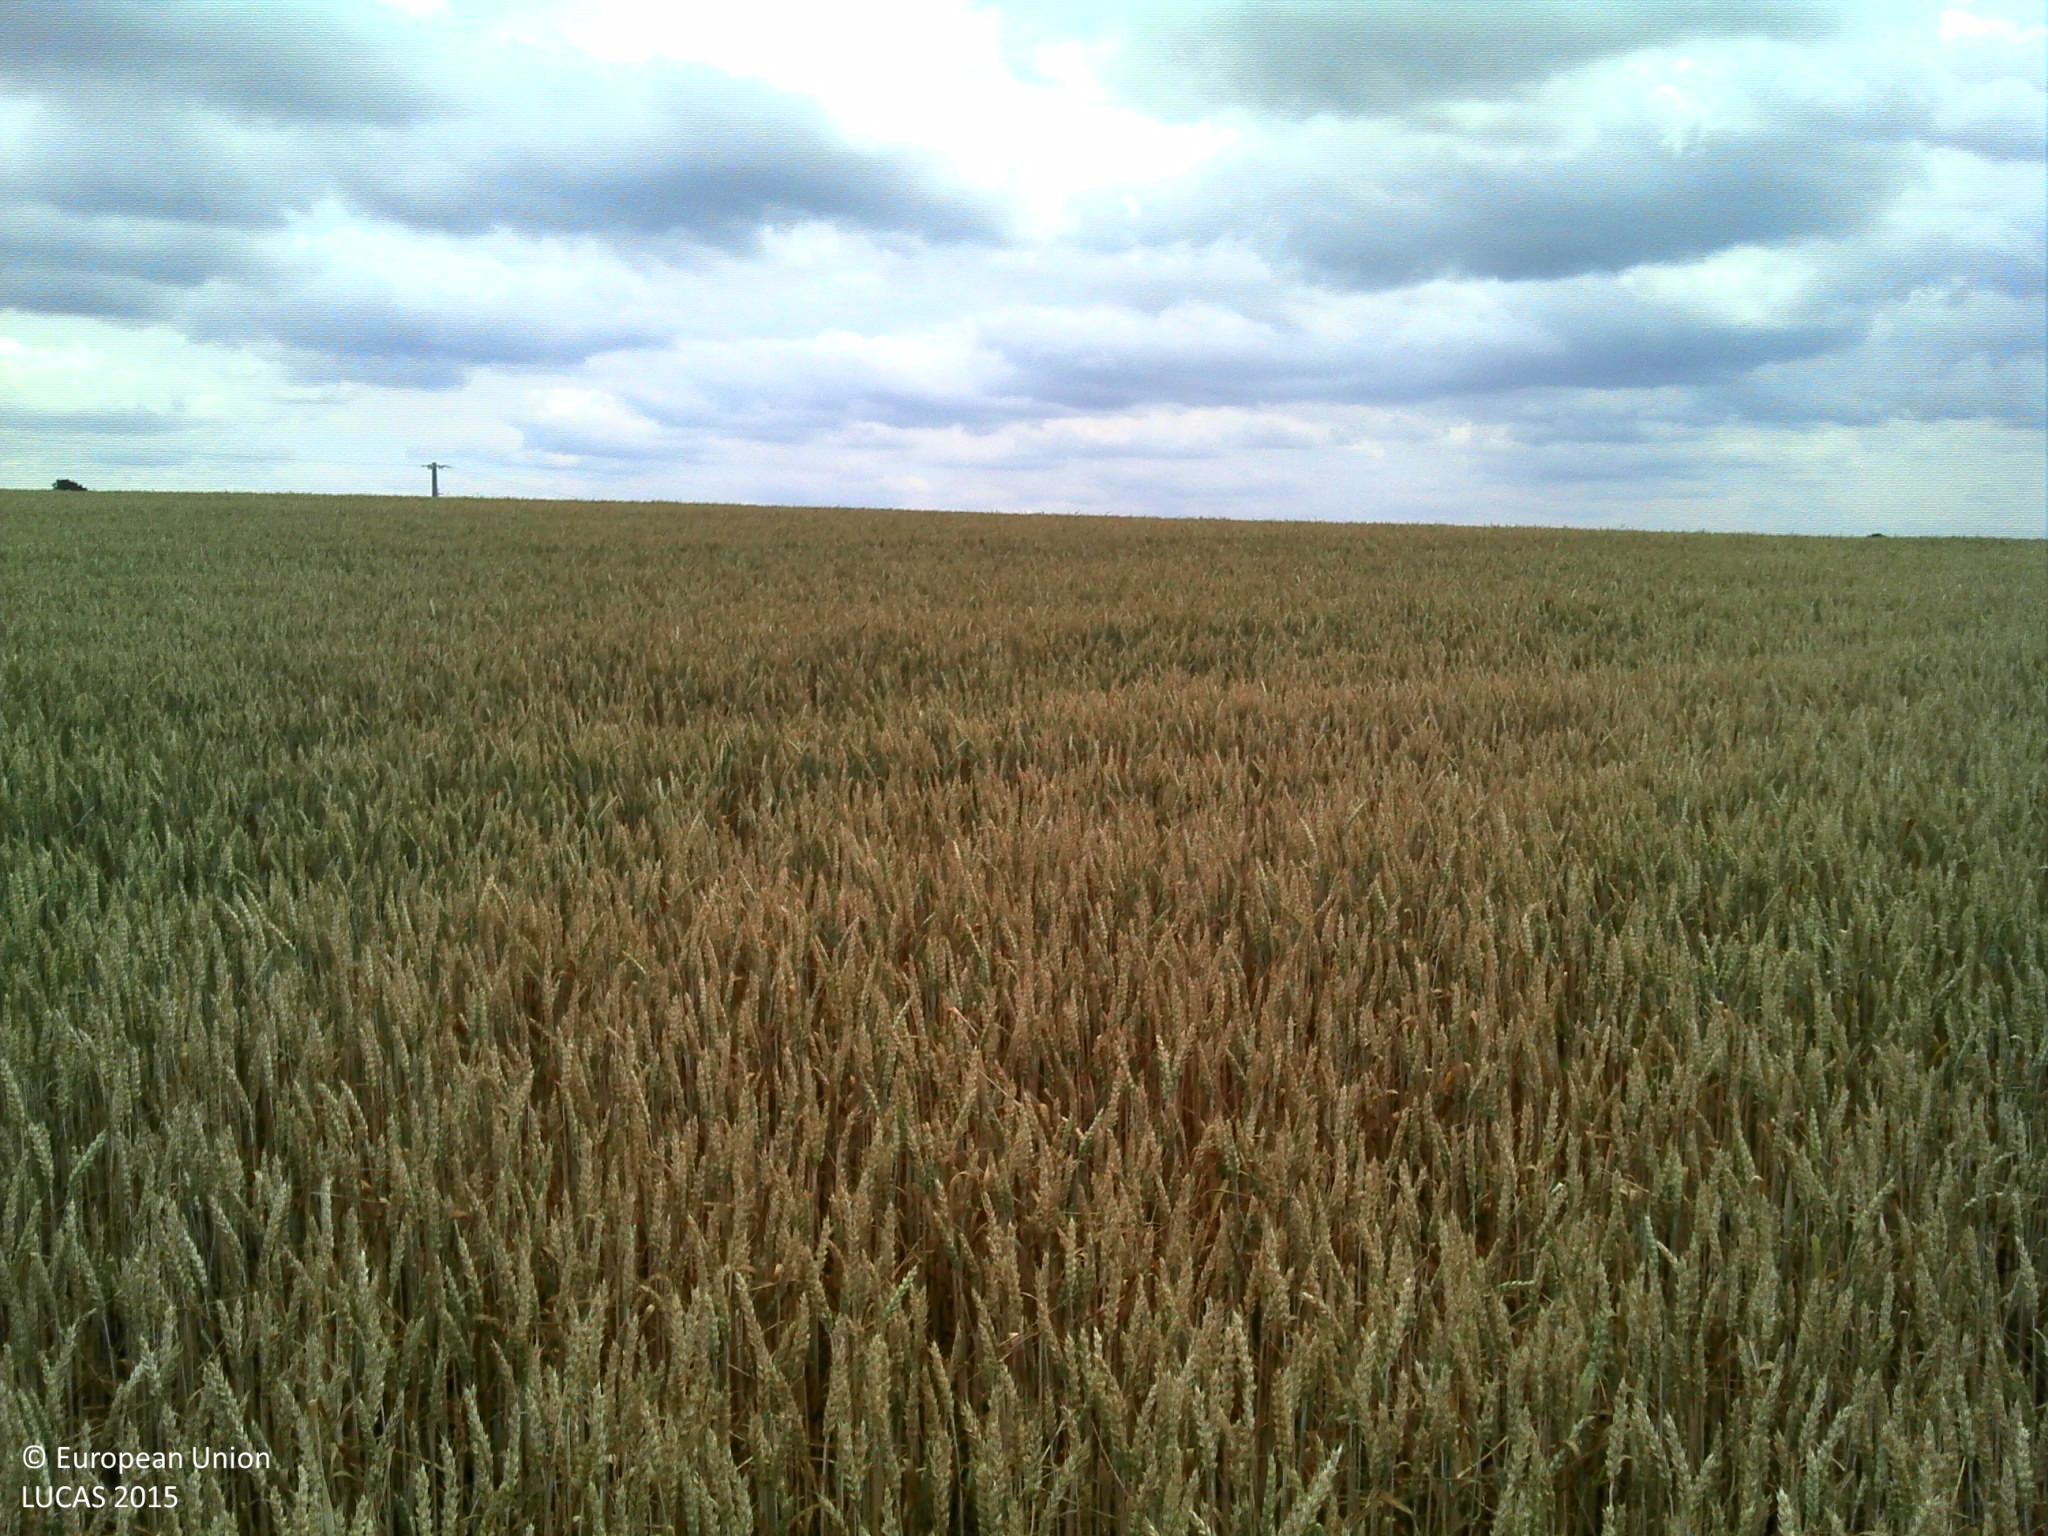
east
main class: Cropland
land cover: Common wheat
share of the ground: > 75 %
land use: Agriculture (excluding fallow land and kitchen gardens)
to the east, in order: Common wheat; Electric lines; Common wheat
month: July
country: BE
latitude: 49.7223
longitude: 5.6293
